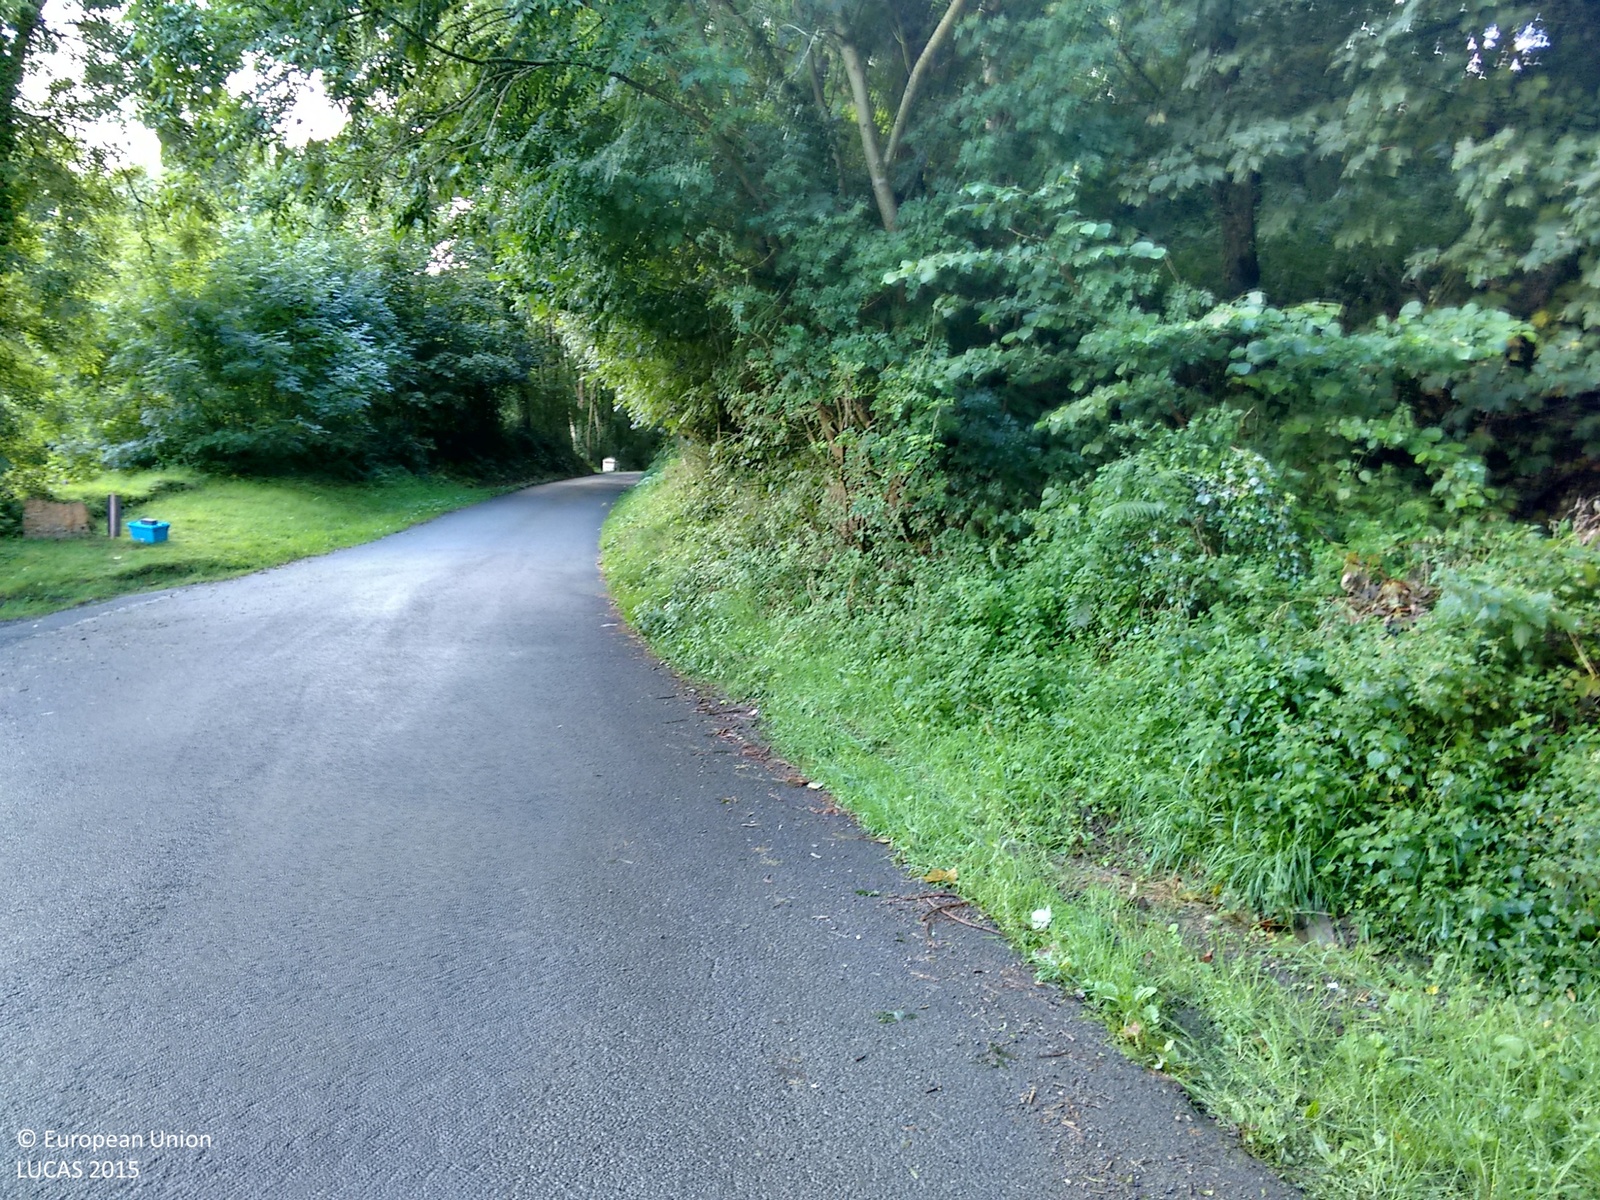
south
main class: Woodland
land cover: Broadleaved woodland
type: mesophytic deciduous forest
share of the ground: > 75 %
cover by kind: broadleaved forest trees 80 %, shrubs 20 %
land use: Semi-natural and natural areas not in use
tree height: > 5 m
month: August
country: GB
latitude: 51.9936
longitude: -4.9267
